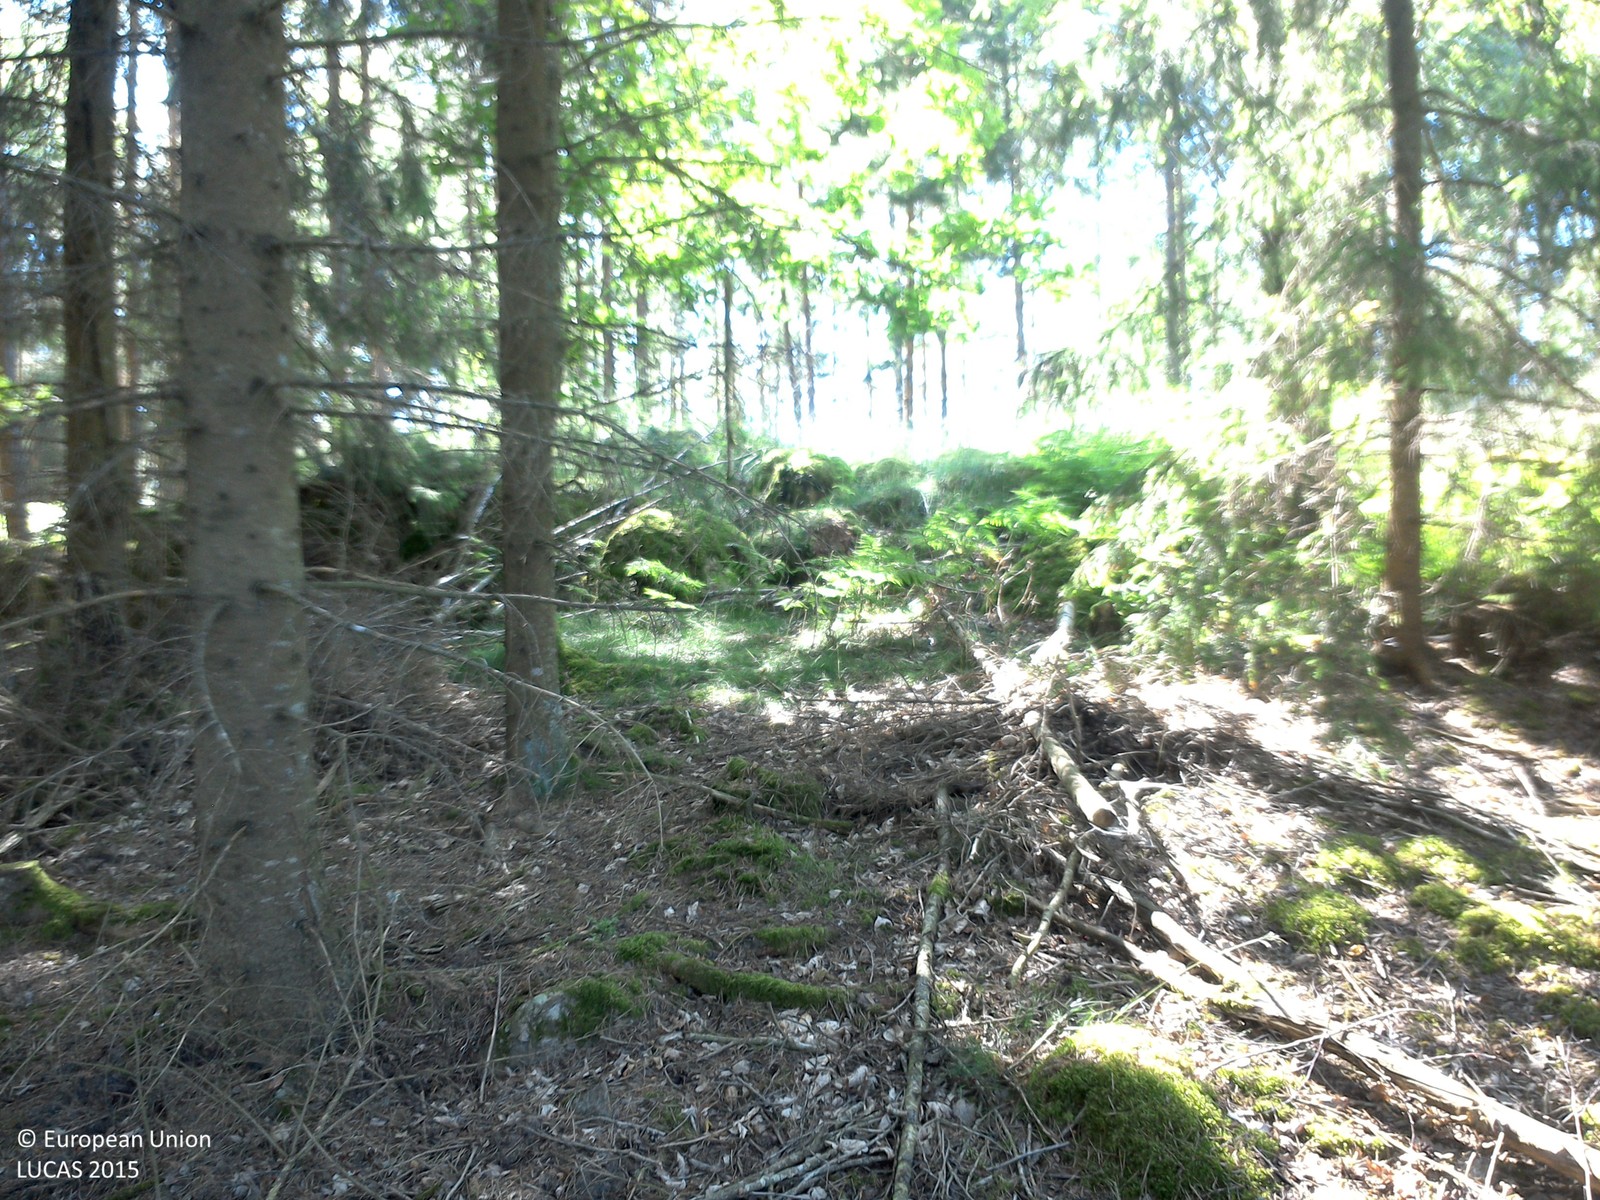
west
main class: Woodland
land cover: Spruce dominated coniferous woodland
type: boreal forest
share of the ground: > 75 %
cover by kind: coniferous forest trees 75 %, lichens and mosses 20 %, herbaceous plants 5 %
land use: Forestry
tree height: > 5 m
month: July
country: SE
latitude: 58.3451
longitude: 15.4101
